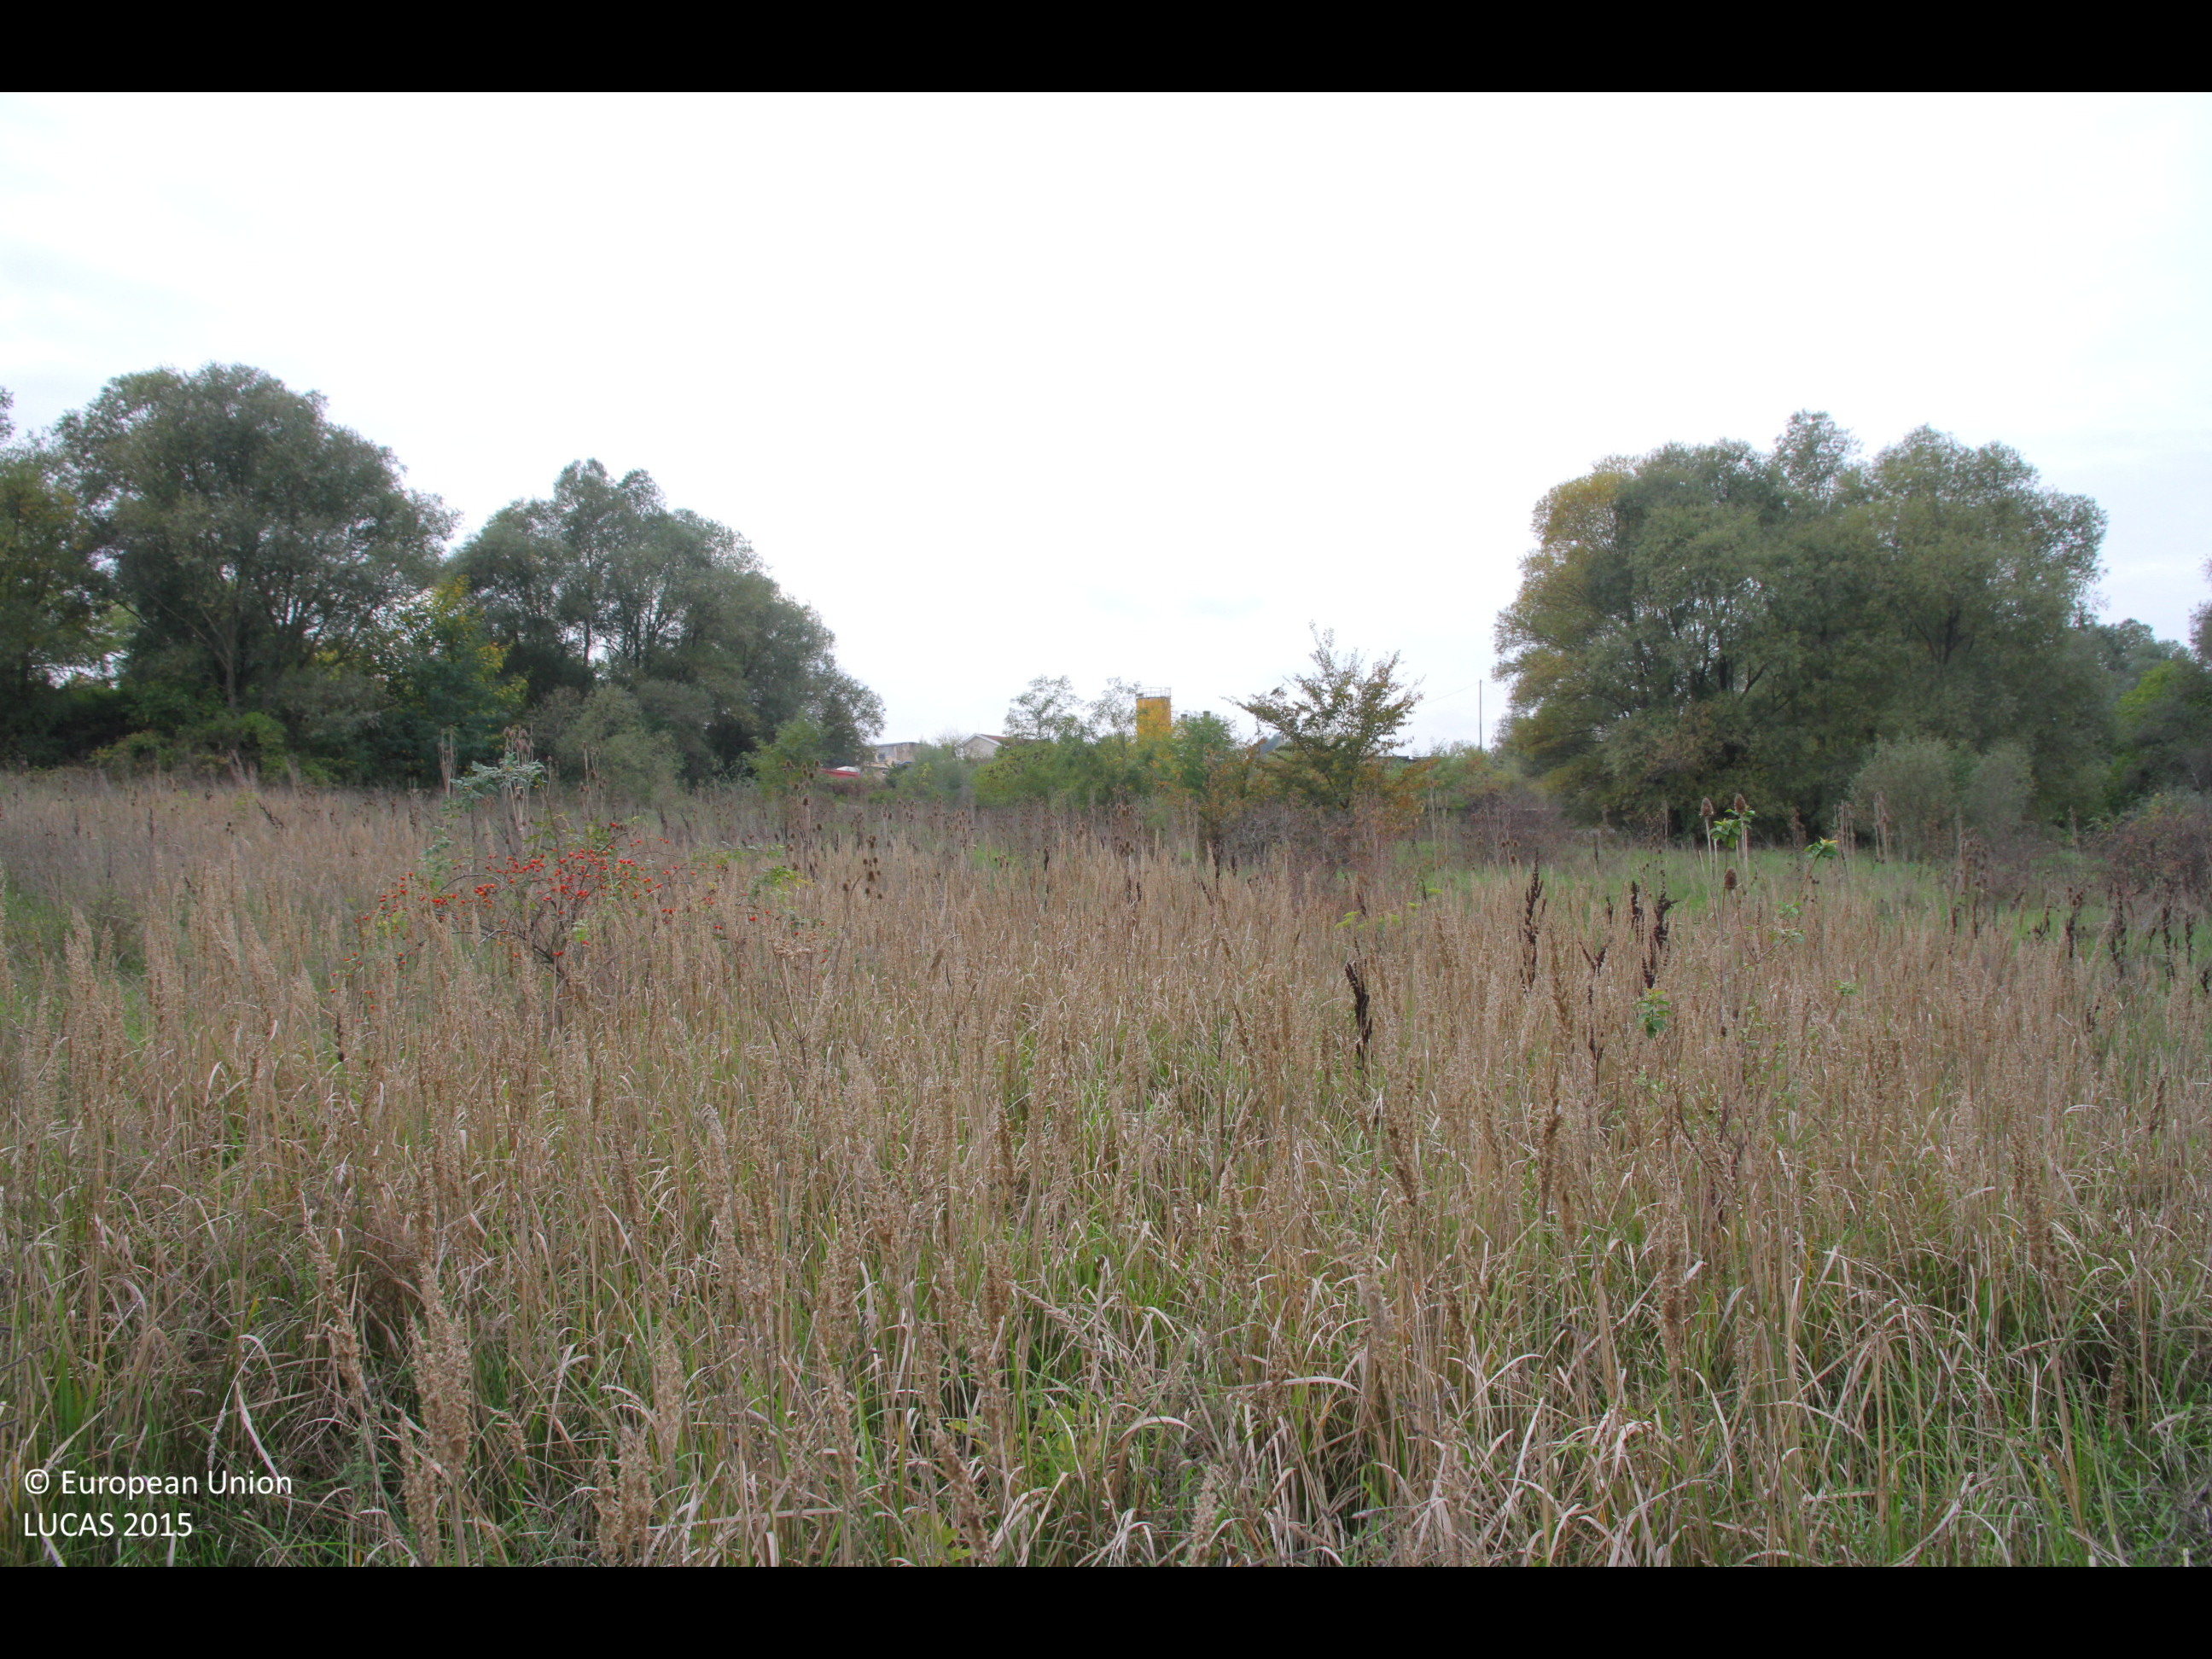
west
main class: Grassland
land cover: Grassland without tree/shrub cover
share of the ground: > 75 %
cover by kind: herbaceous plants 95 %, shrubs 5 %
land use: Semi-natural and natural areas not in use
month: October
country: BG
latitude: 43.2912
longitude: 26.9623
